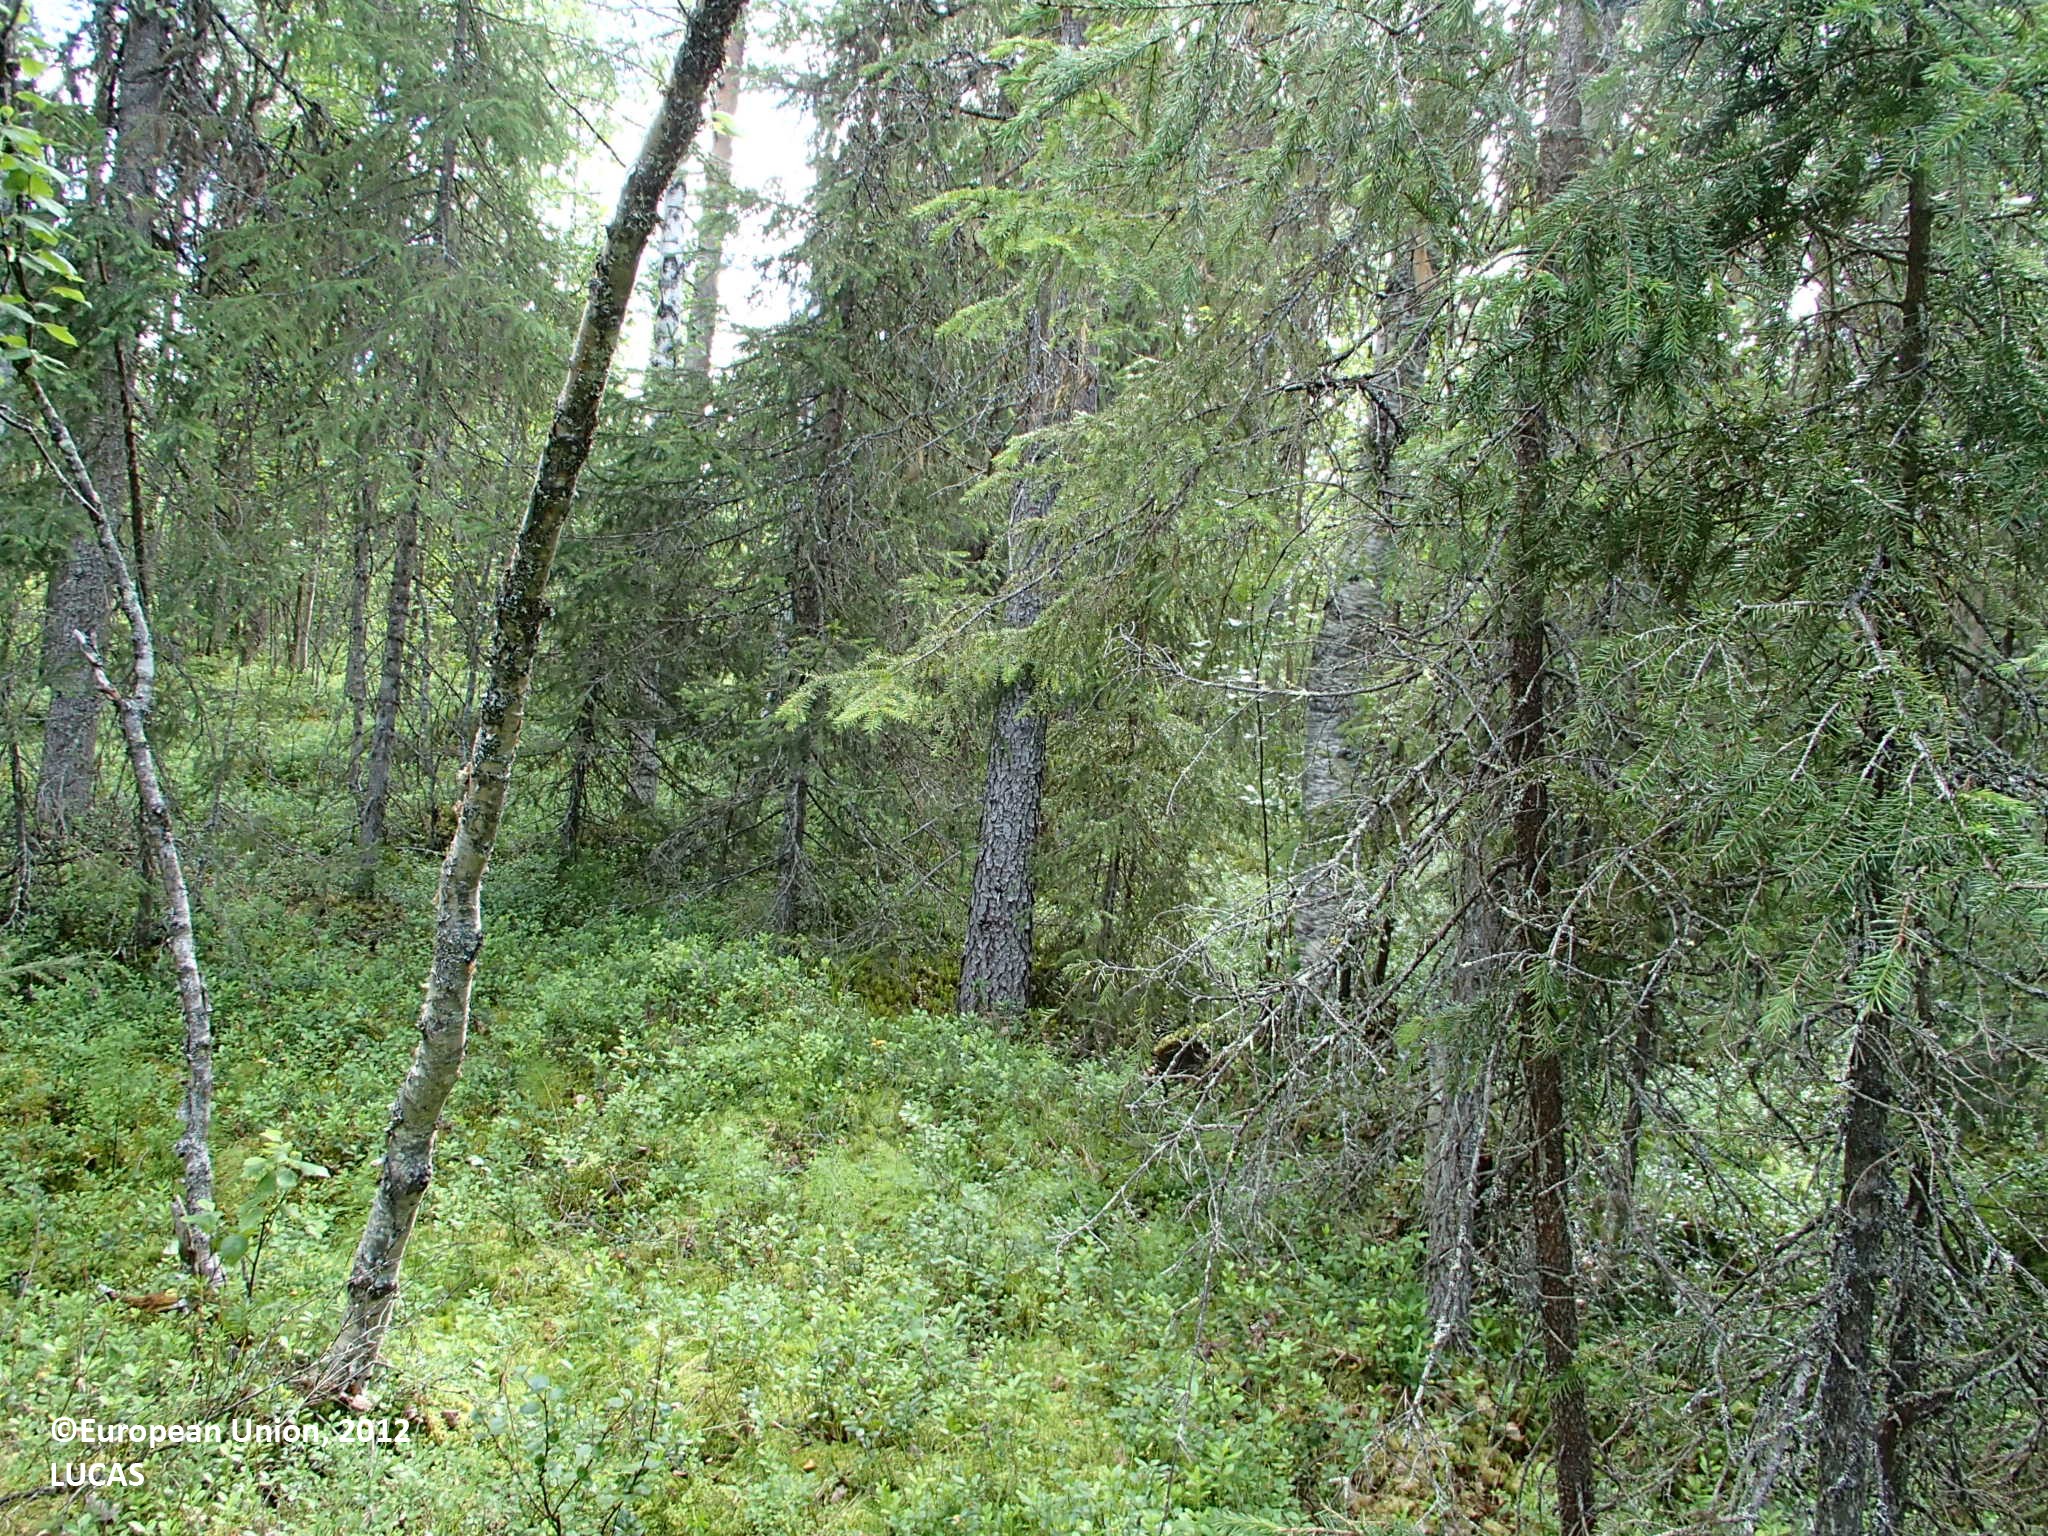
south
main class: Woodland
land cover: Spruce dominated mixed woodland
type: boreal forest
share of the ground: > 75 %
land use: Forestry
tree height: > 5 m
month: July
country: FI
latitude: 66.6984
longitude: 25.3496
